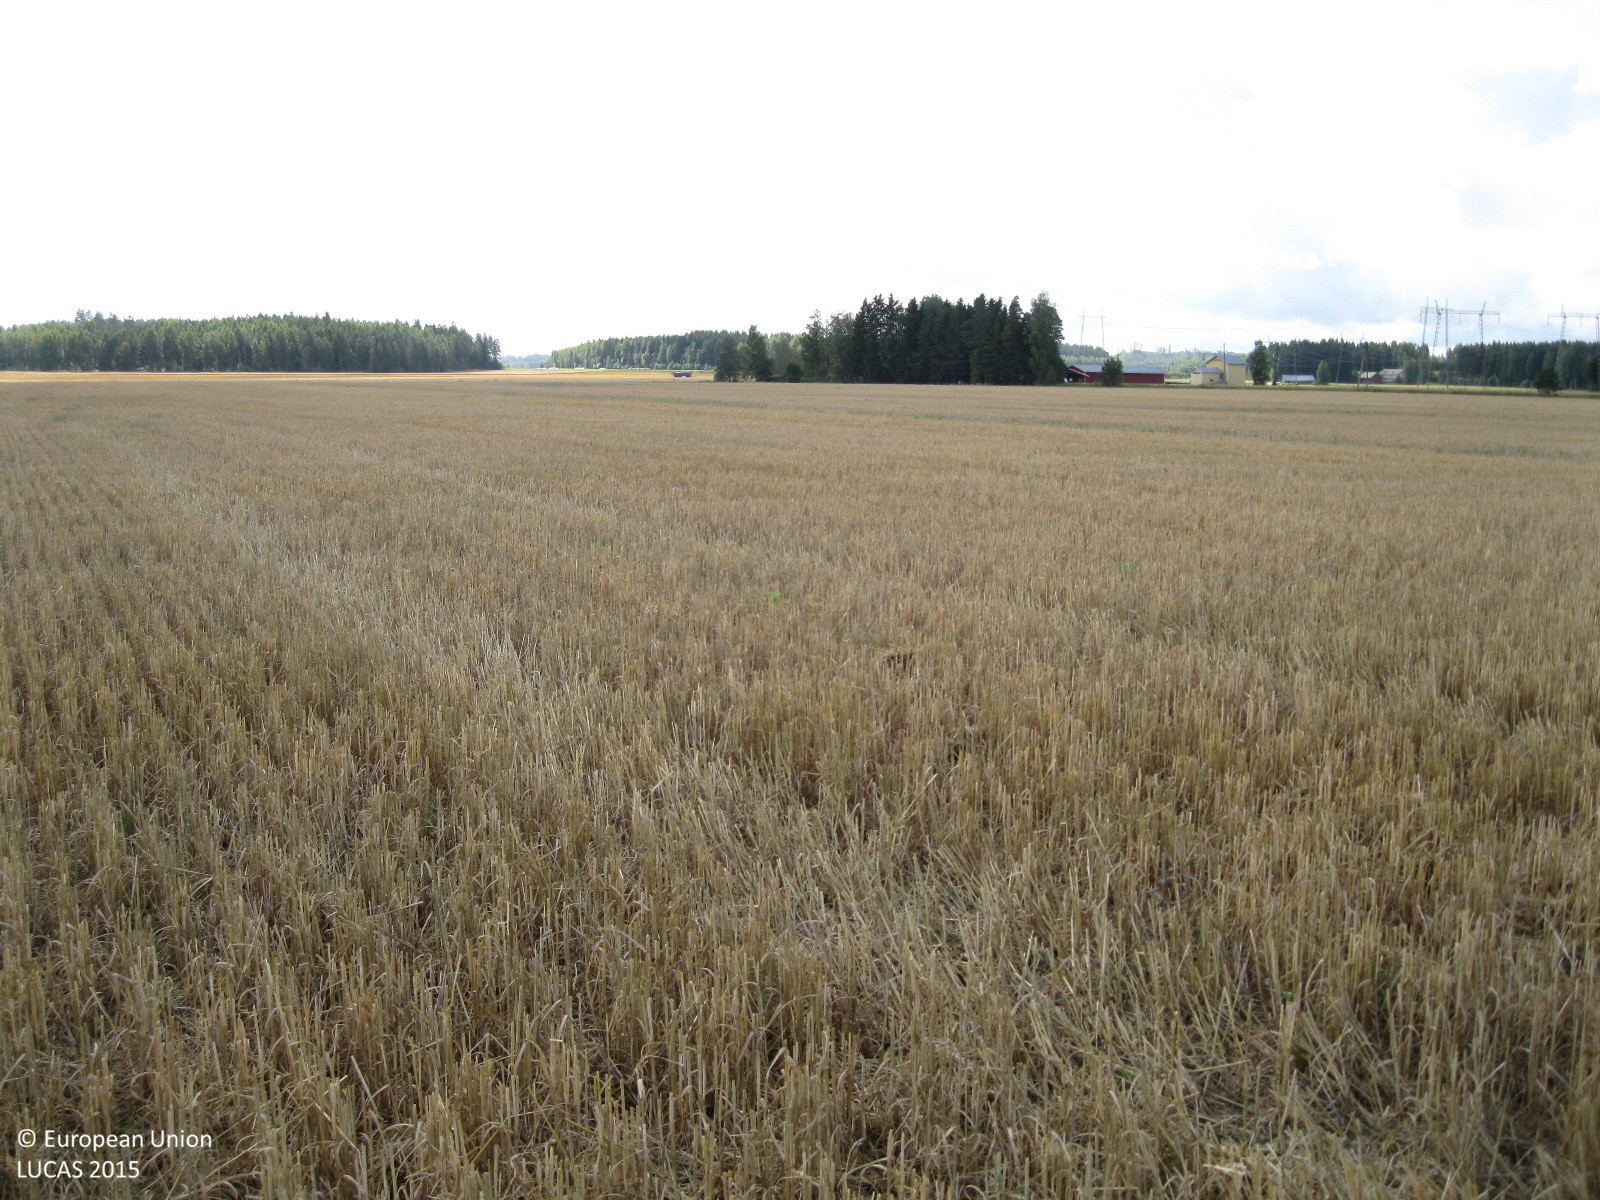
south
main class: Cropland
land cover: Common wheat
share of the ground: > 75 %
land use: Agriculture (excluding fallow land and kitchen gardens)
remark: Harvested field
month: September
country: FI
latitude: 60.8324
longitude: 24.9202
